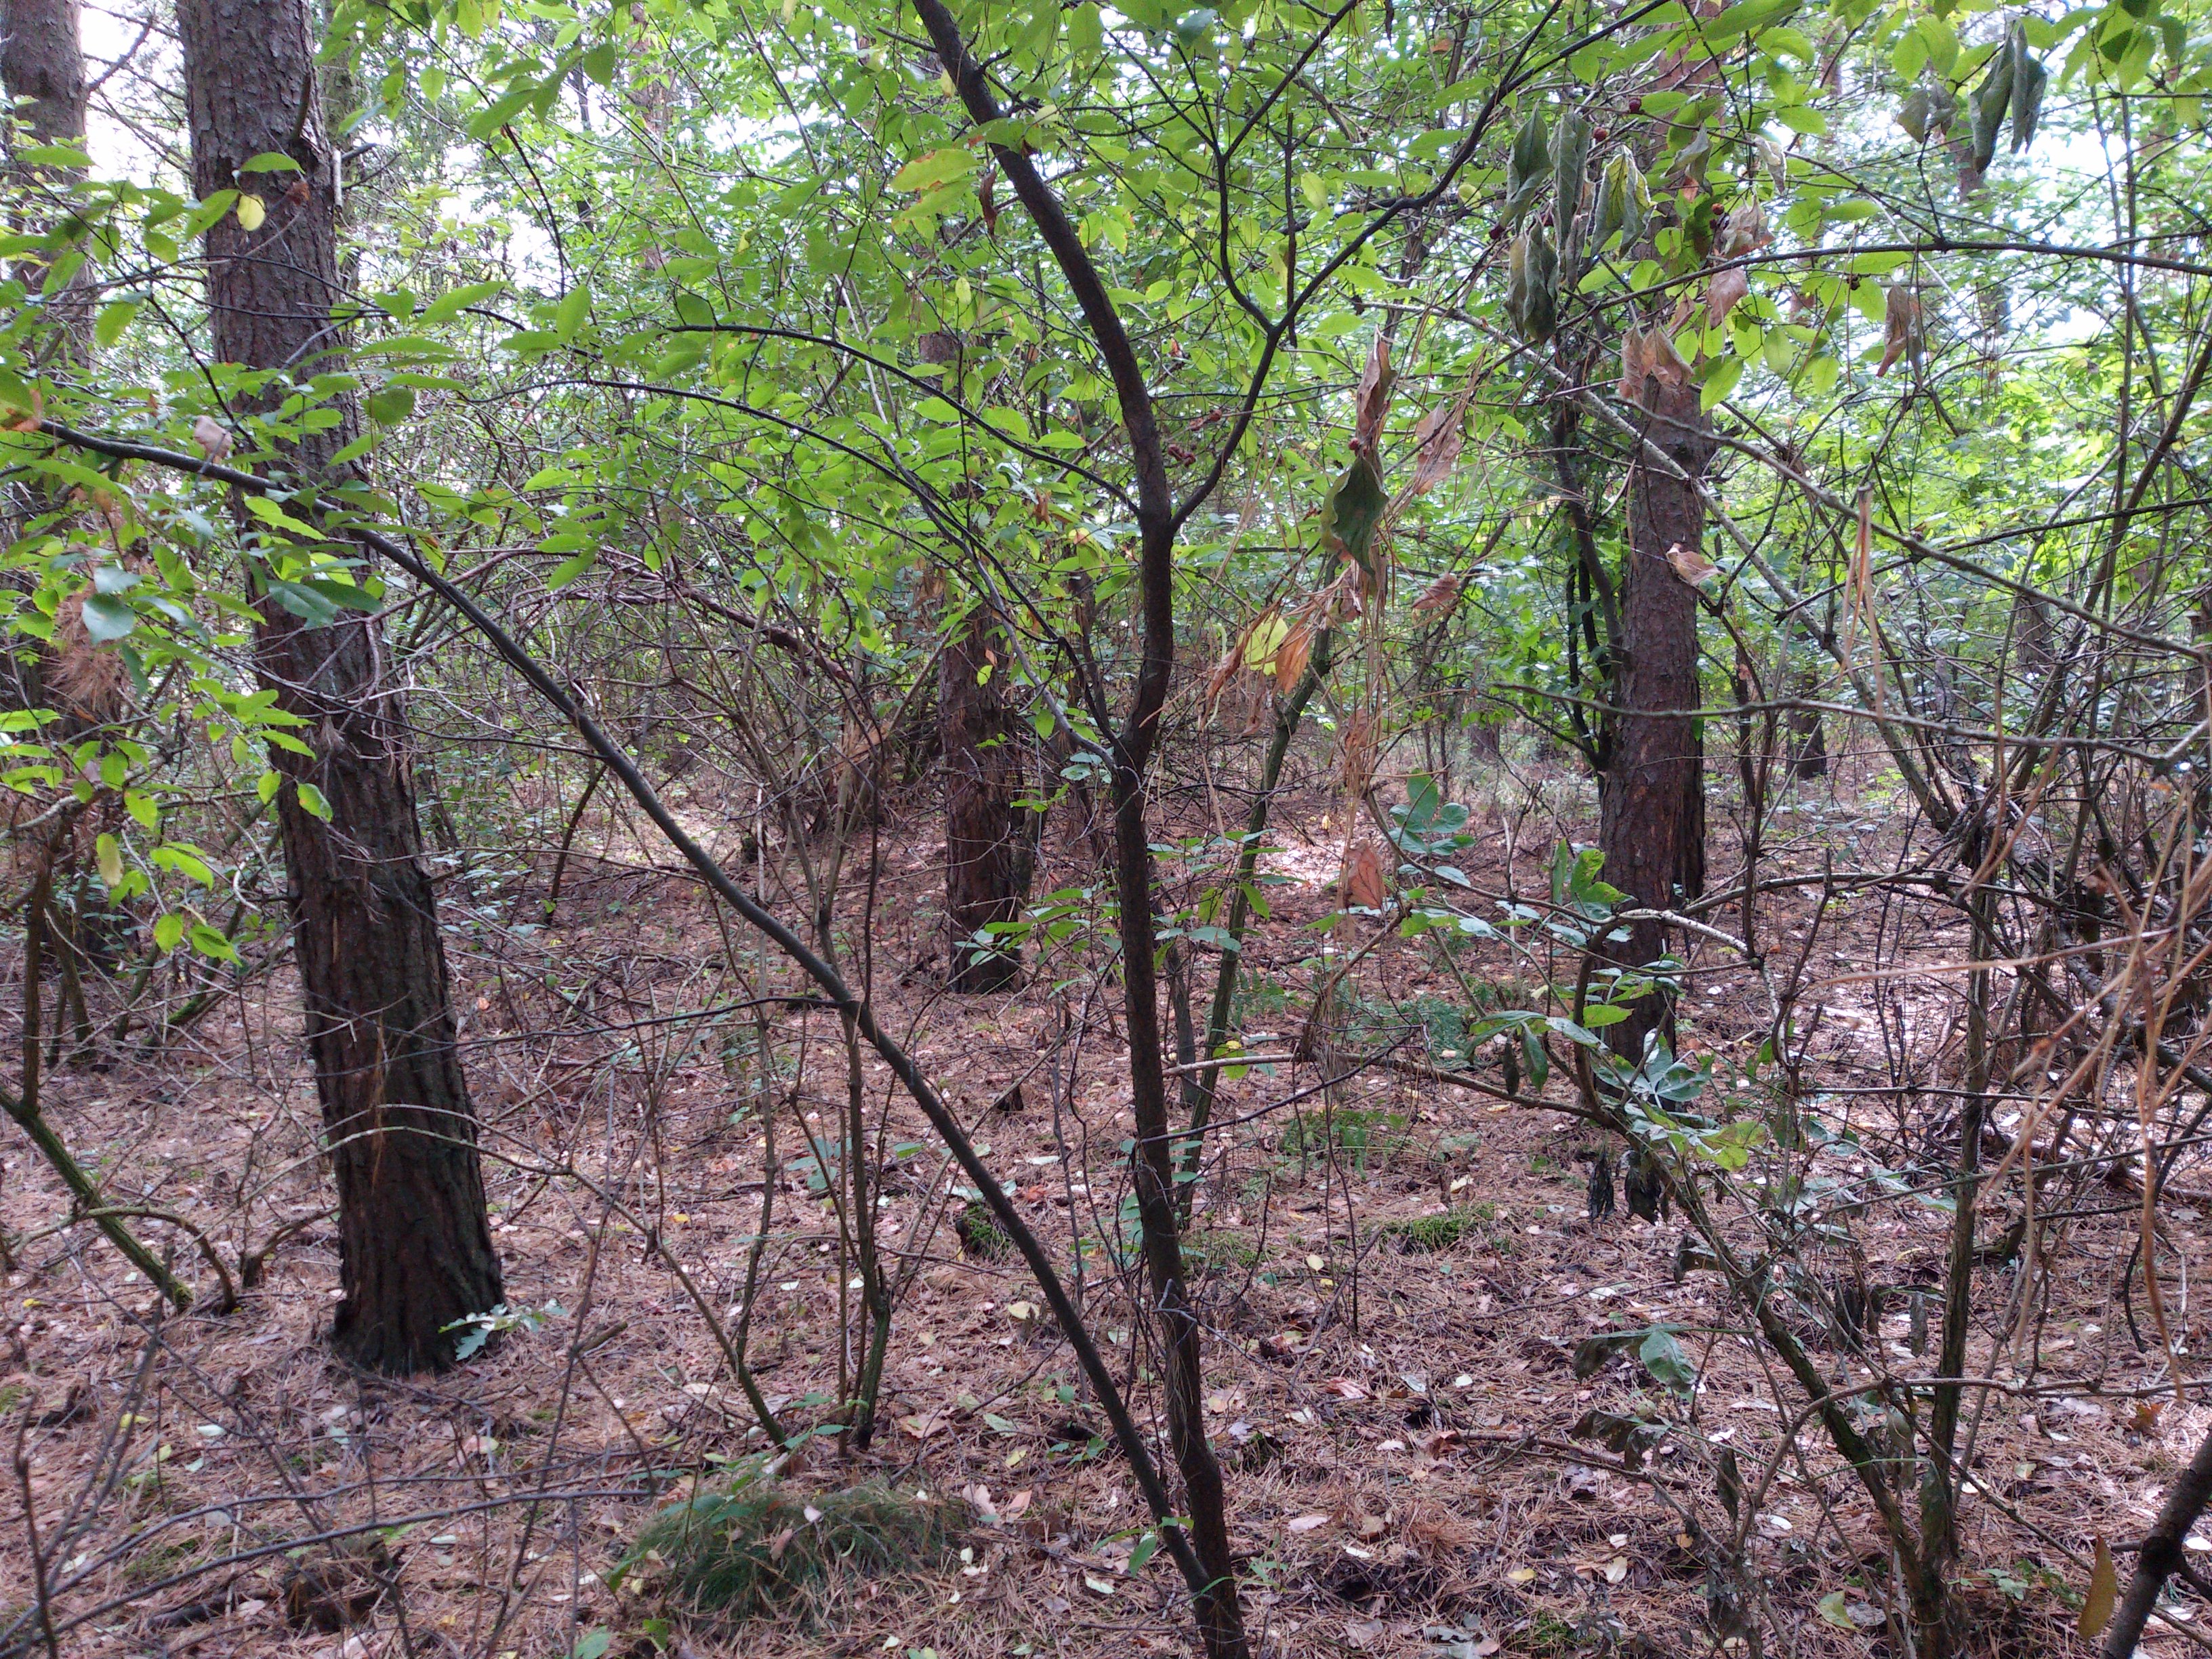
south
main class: Woodland
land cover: Pine dominated mixed woodland
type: hemiboreal forest and nemoral coniferous forest and mixed broadleaved-coniferous forest
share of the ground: > 75 %
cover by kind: coniferous forest trees 60 %, broadleaved forest trees 25 %, shrubs 10 %, unconsolidated bare surface 5 %
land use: Forestry
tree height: > 5 m
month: September
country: PL
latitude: 53.1219
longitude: 17.6787
